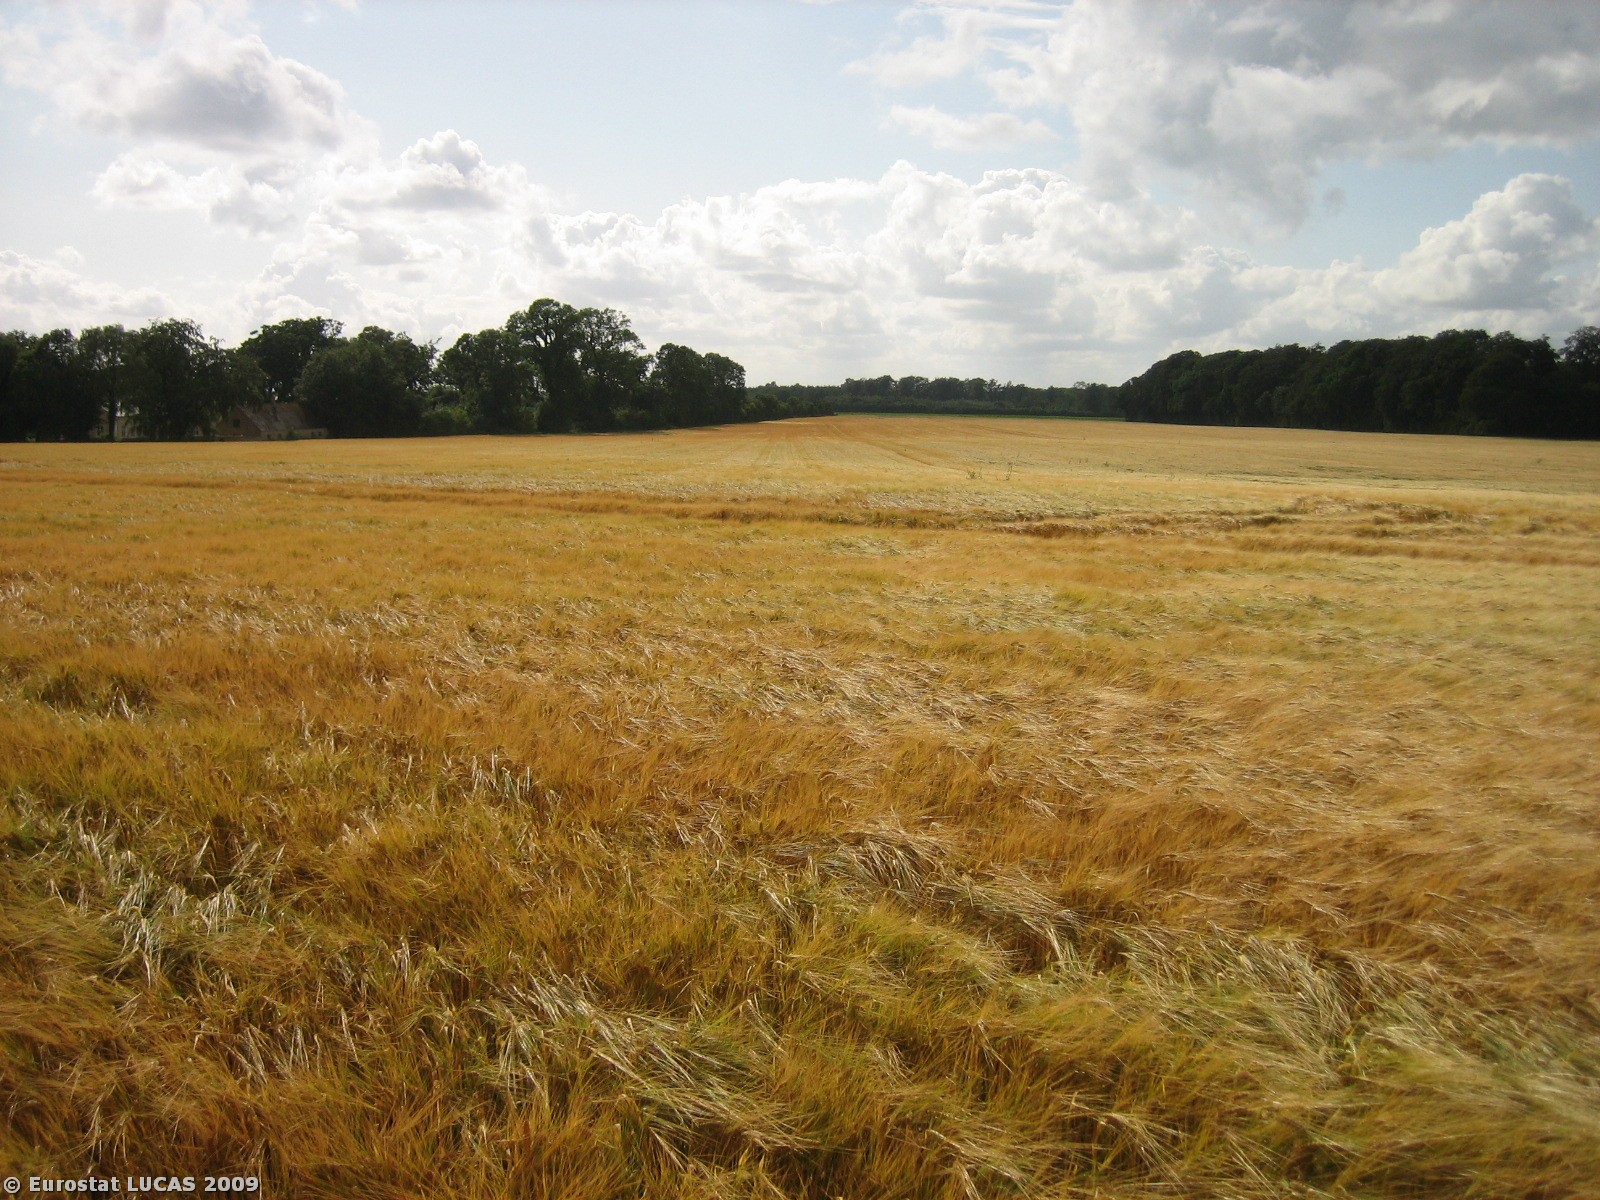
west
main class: Cropland
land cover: Barley
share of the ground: > 75 %
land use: Agriculture (excluding fallow land and kitchen gardens)
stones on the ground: < 10 %
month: July
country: DK
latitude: 55.3968
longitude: 9.8580
